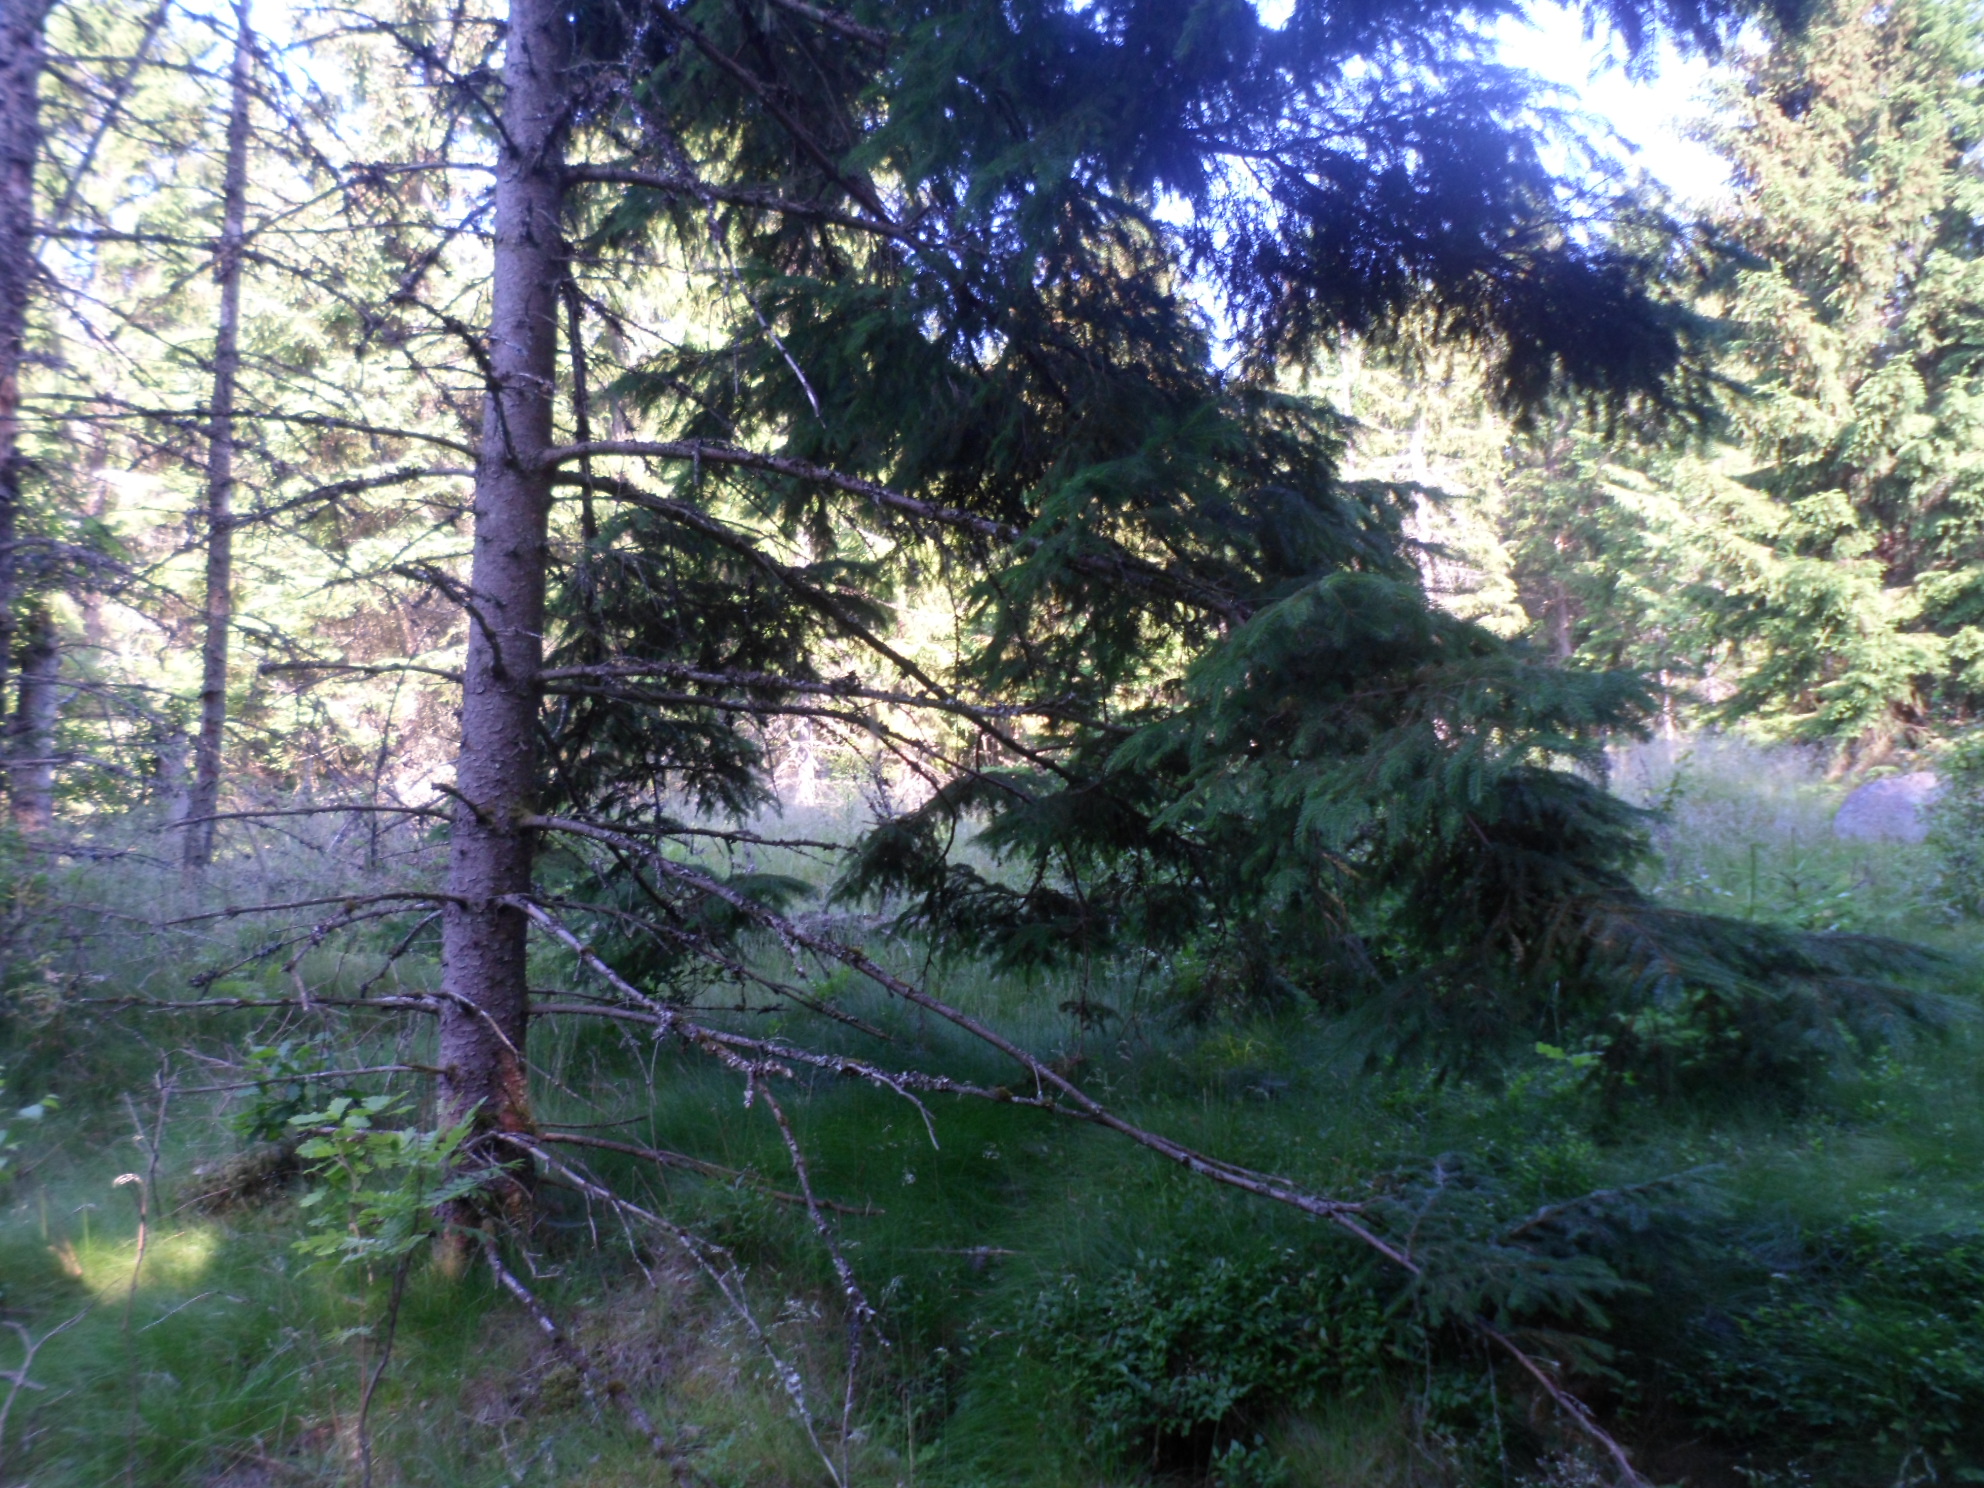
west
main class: Woodland
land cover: Spruce dominated coniferous woodland
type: boreal forest
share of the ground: 50 - 75 %
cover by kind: coniferous forest trees 50 %, herbaceous plants 30 %, broadleaved forest trees 10 %, shrubs 5 %, lichens and mosses 5 %
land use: Forestry
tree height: > 5 m
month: July
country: SE
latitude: 57.2315
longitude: 14.3197
